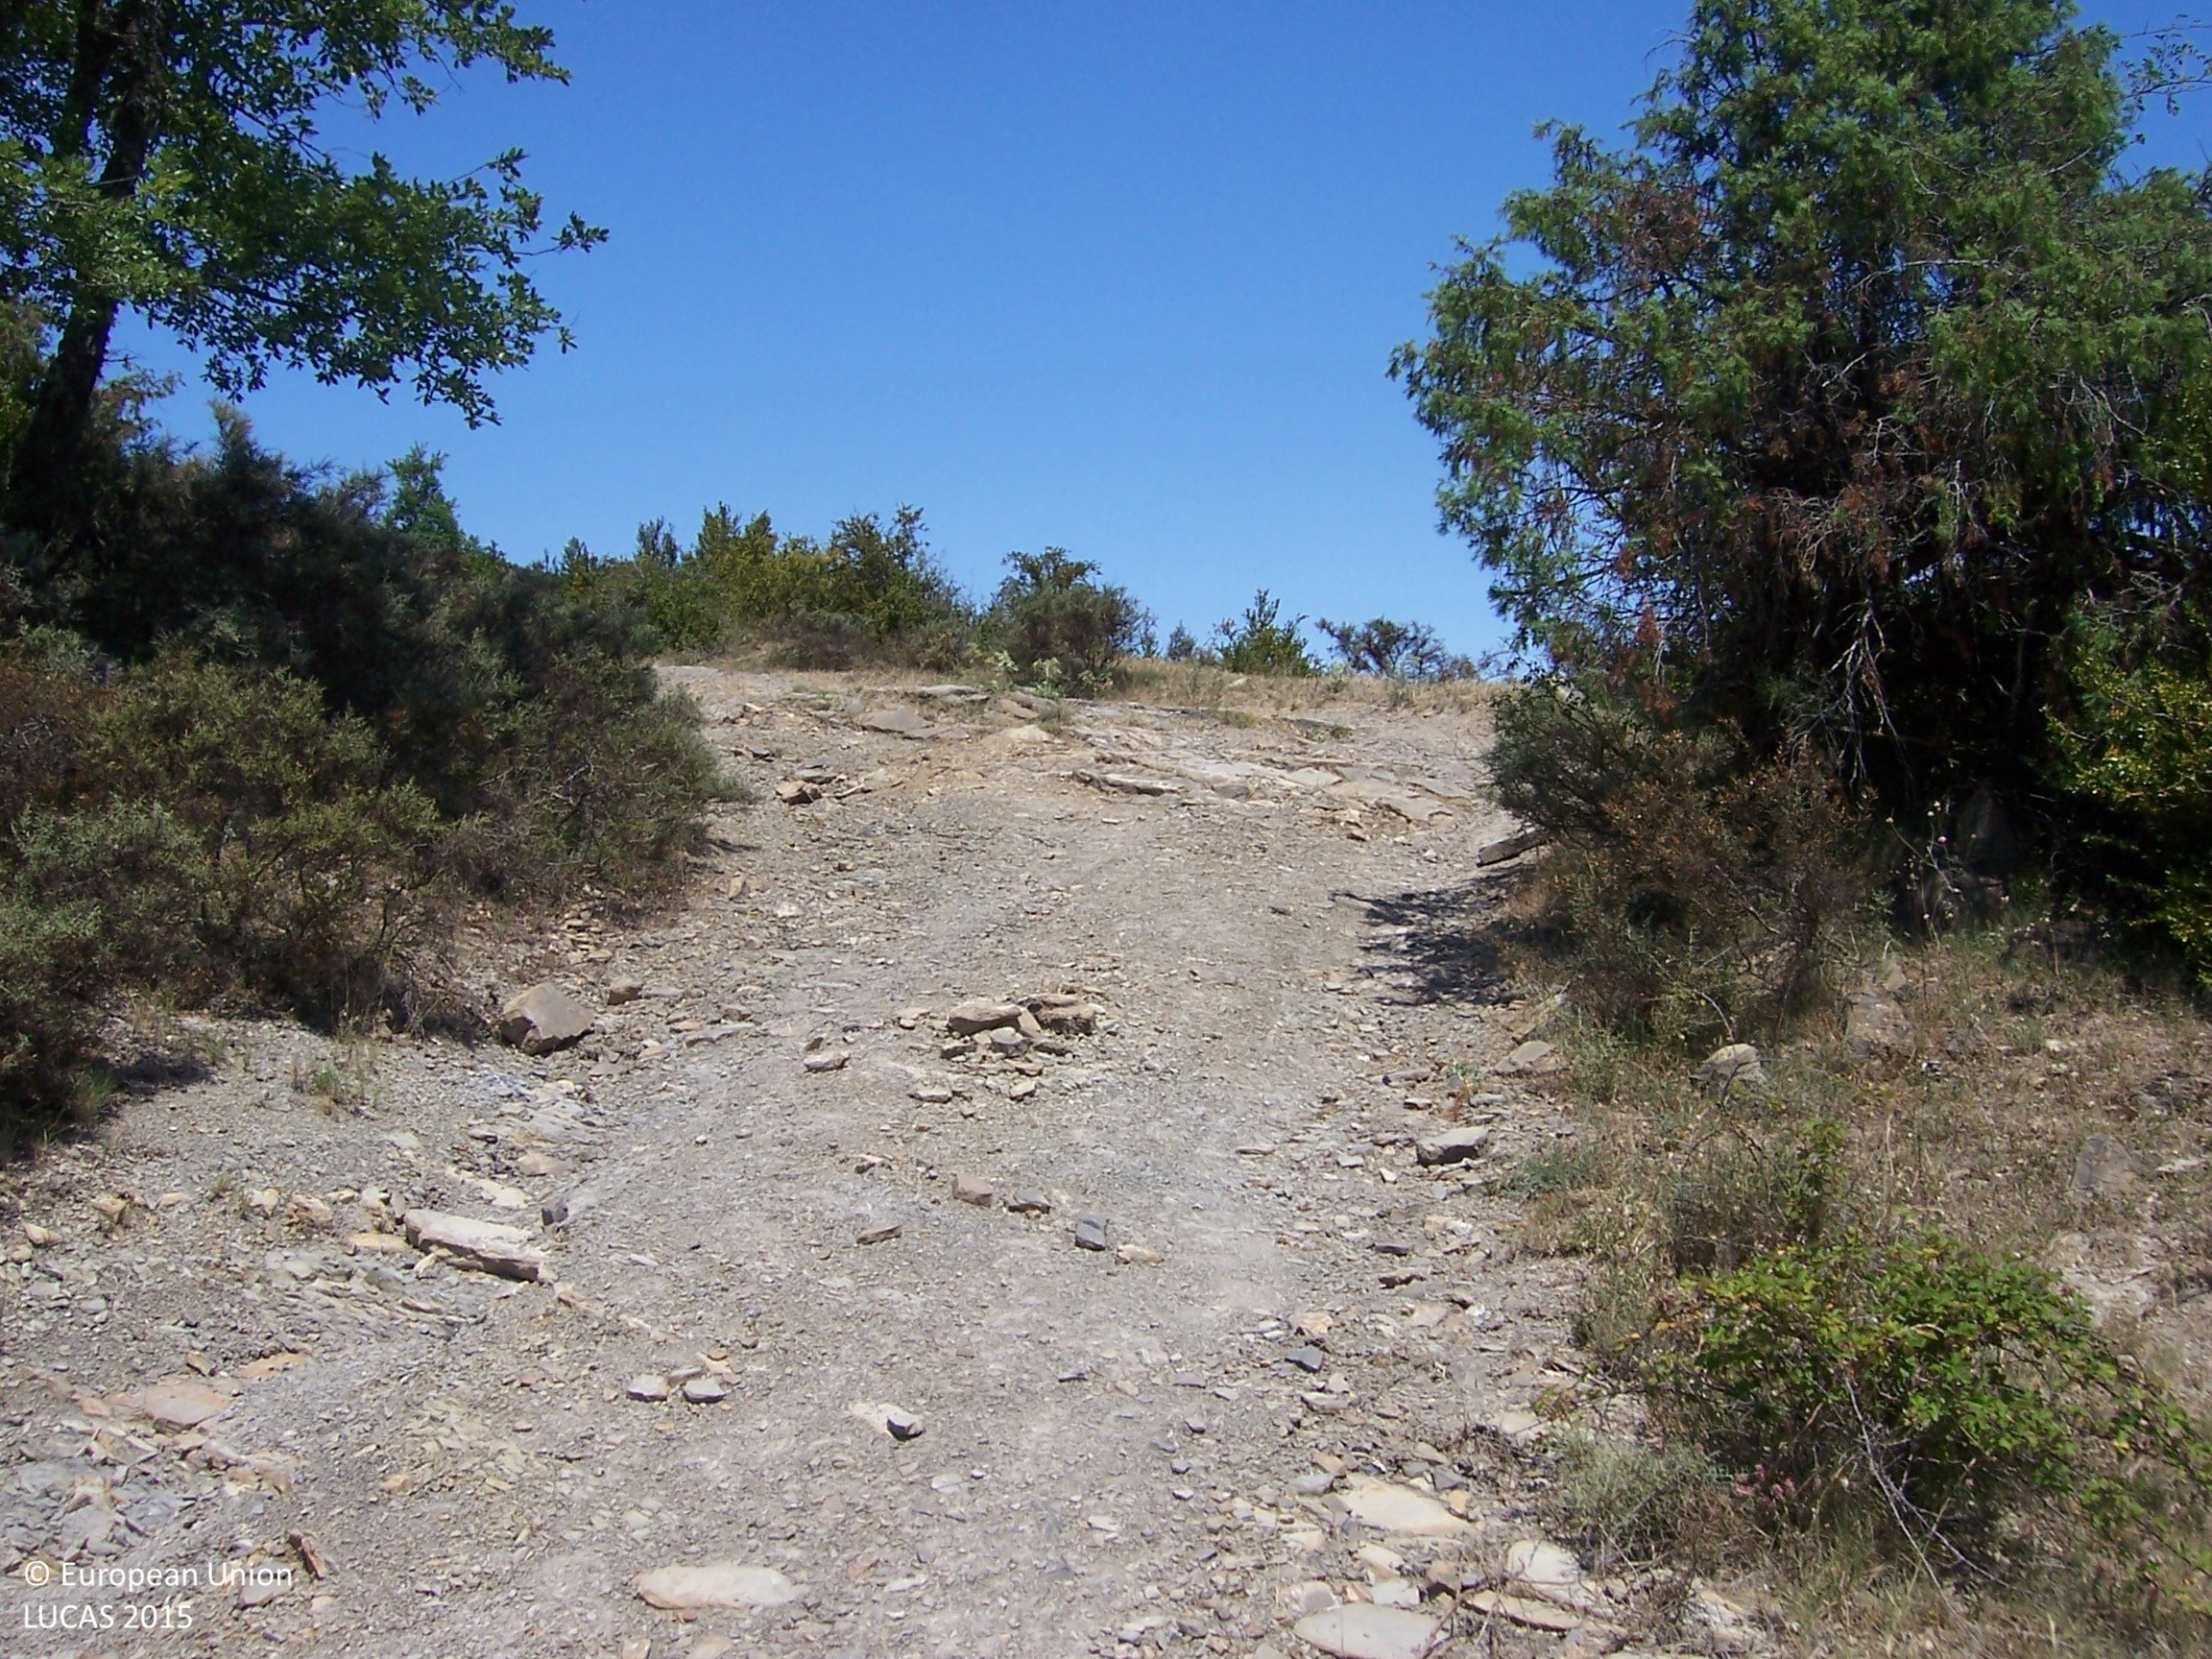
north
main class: Woodland
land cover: Pine dominated coniferous woodland
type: coniferous forest of the mediterranean region
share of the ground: > 75 %
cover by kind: coniferous forest trees 100 %
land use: Forestry
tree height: > 5 m
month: July
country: ES
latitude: 42.8263
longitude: -1.2524
